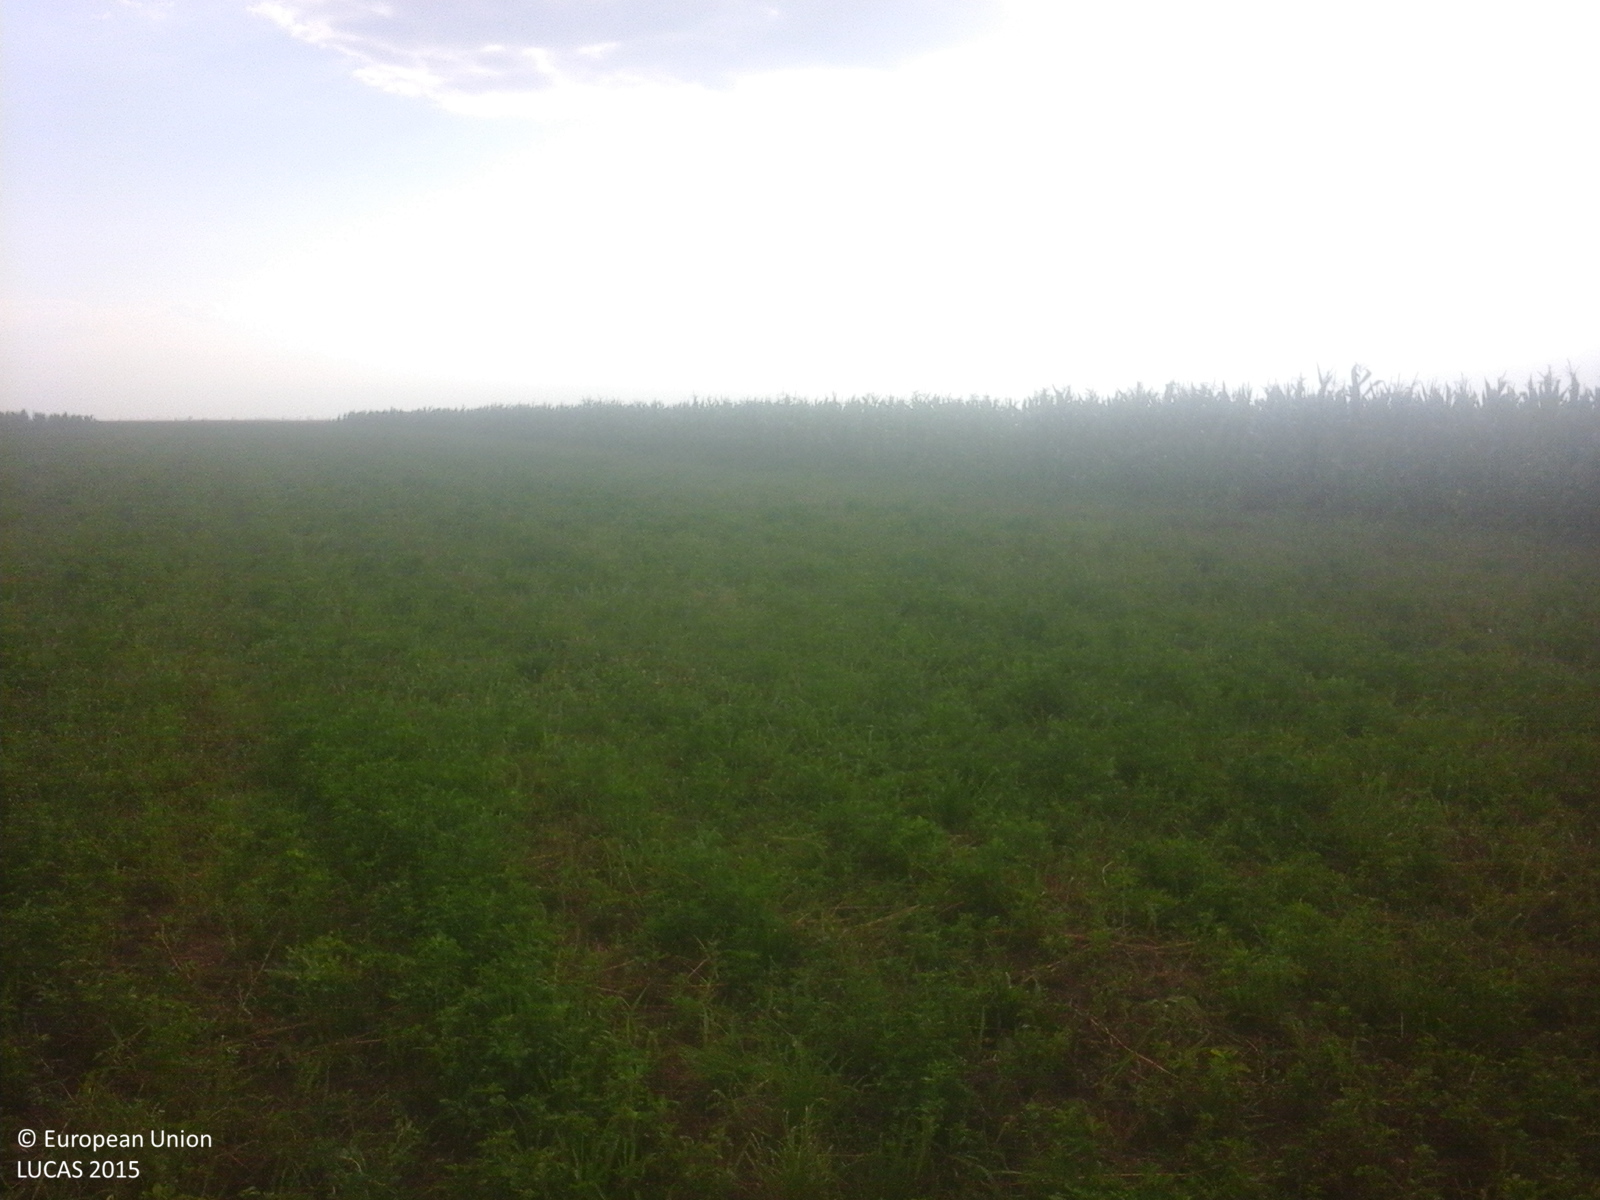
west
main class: Cropland
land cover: Lucerne
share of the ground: > 75 %
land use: Agriculture (excluding fallow land and kitchen gardens)
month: July
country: RO
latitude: 43.8766
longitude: 24.6158
